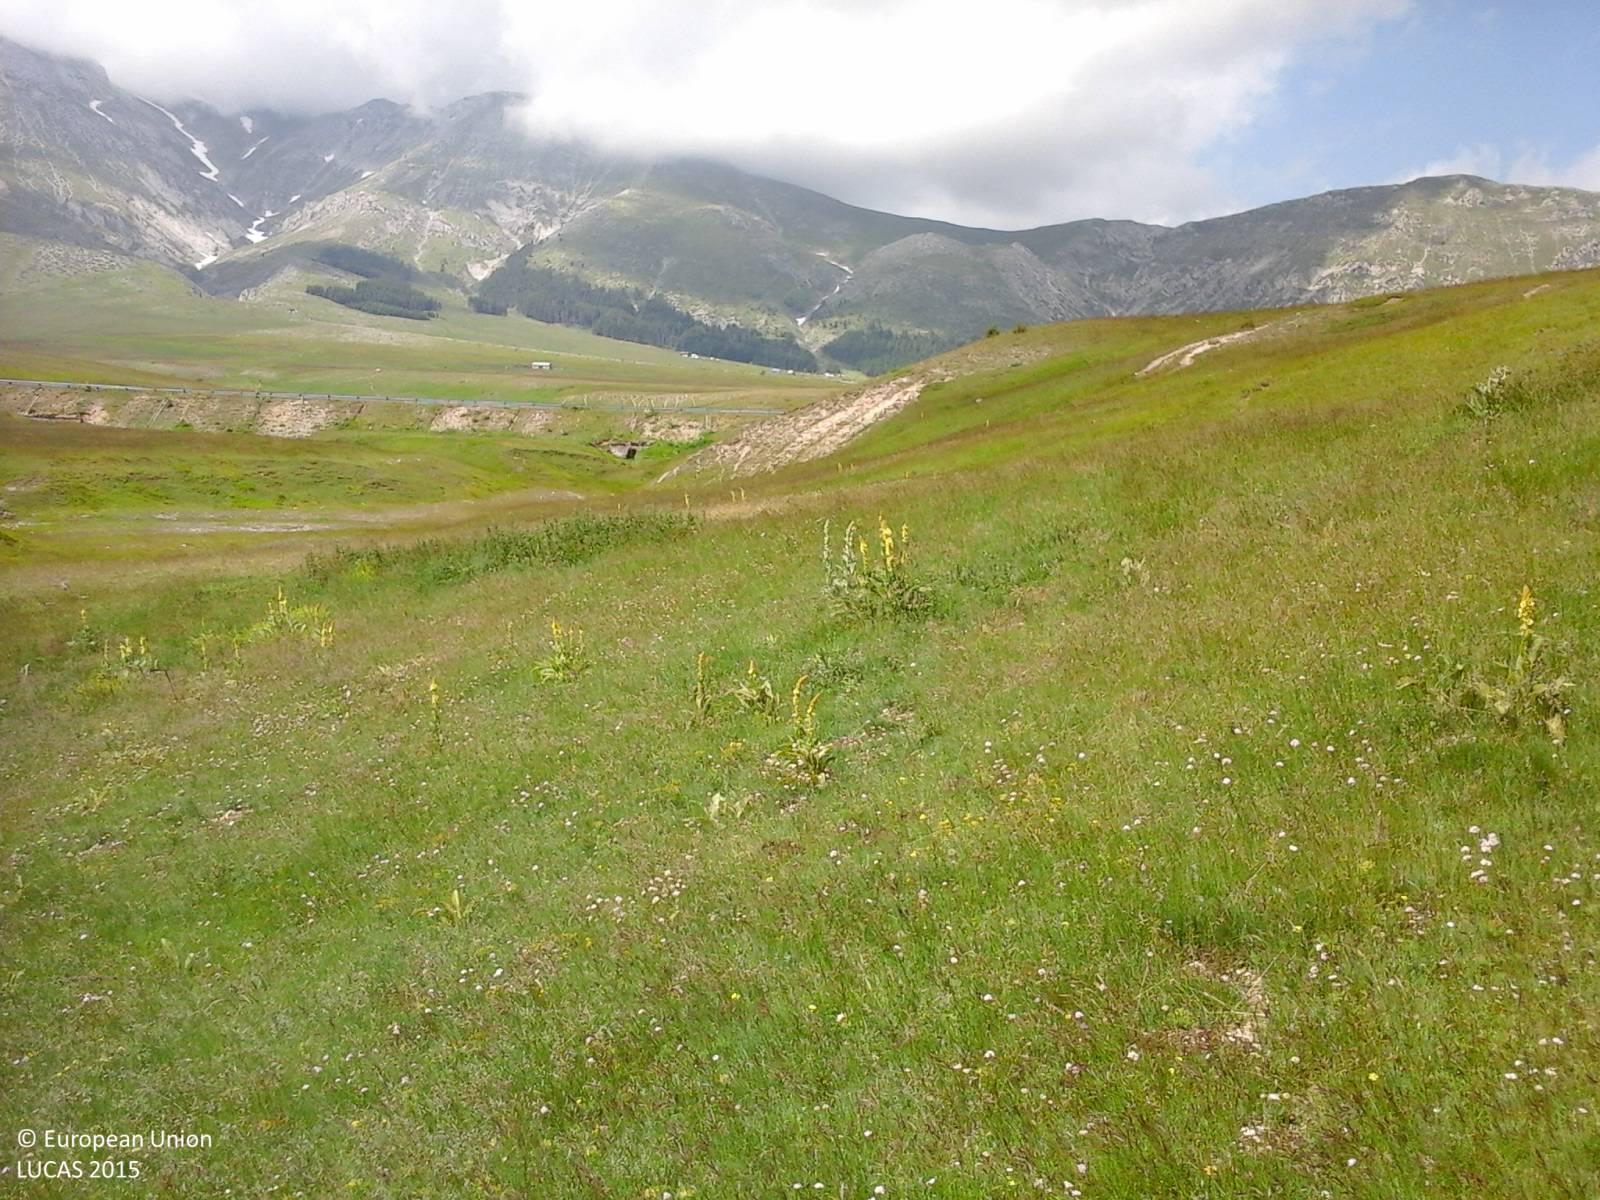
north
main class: Grassland
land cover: Grassland without tree/shrub cover
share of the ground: > 75 %
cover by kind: herbaceous plants 100 %
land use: Agriculture (excluding fallow land and kitchen gardens)
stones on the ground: 10 - 25 %
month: June
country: IT
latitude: 42.4041
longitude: 13.7427
